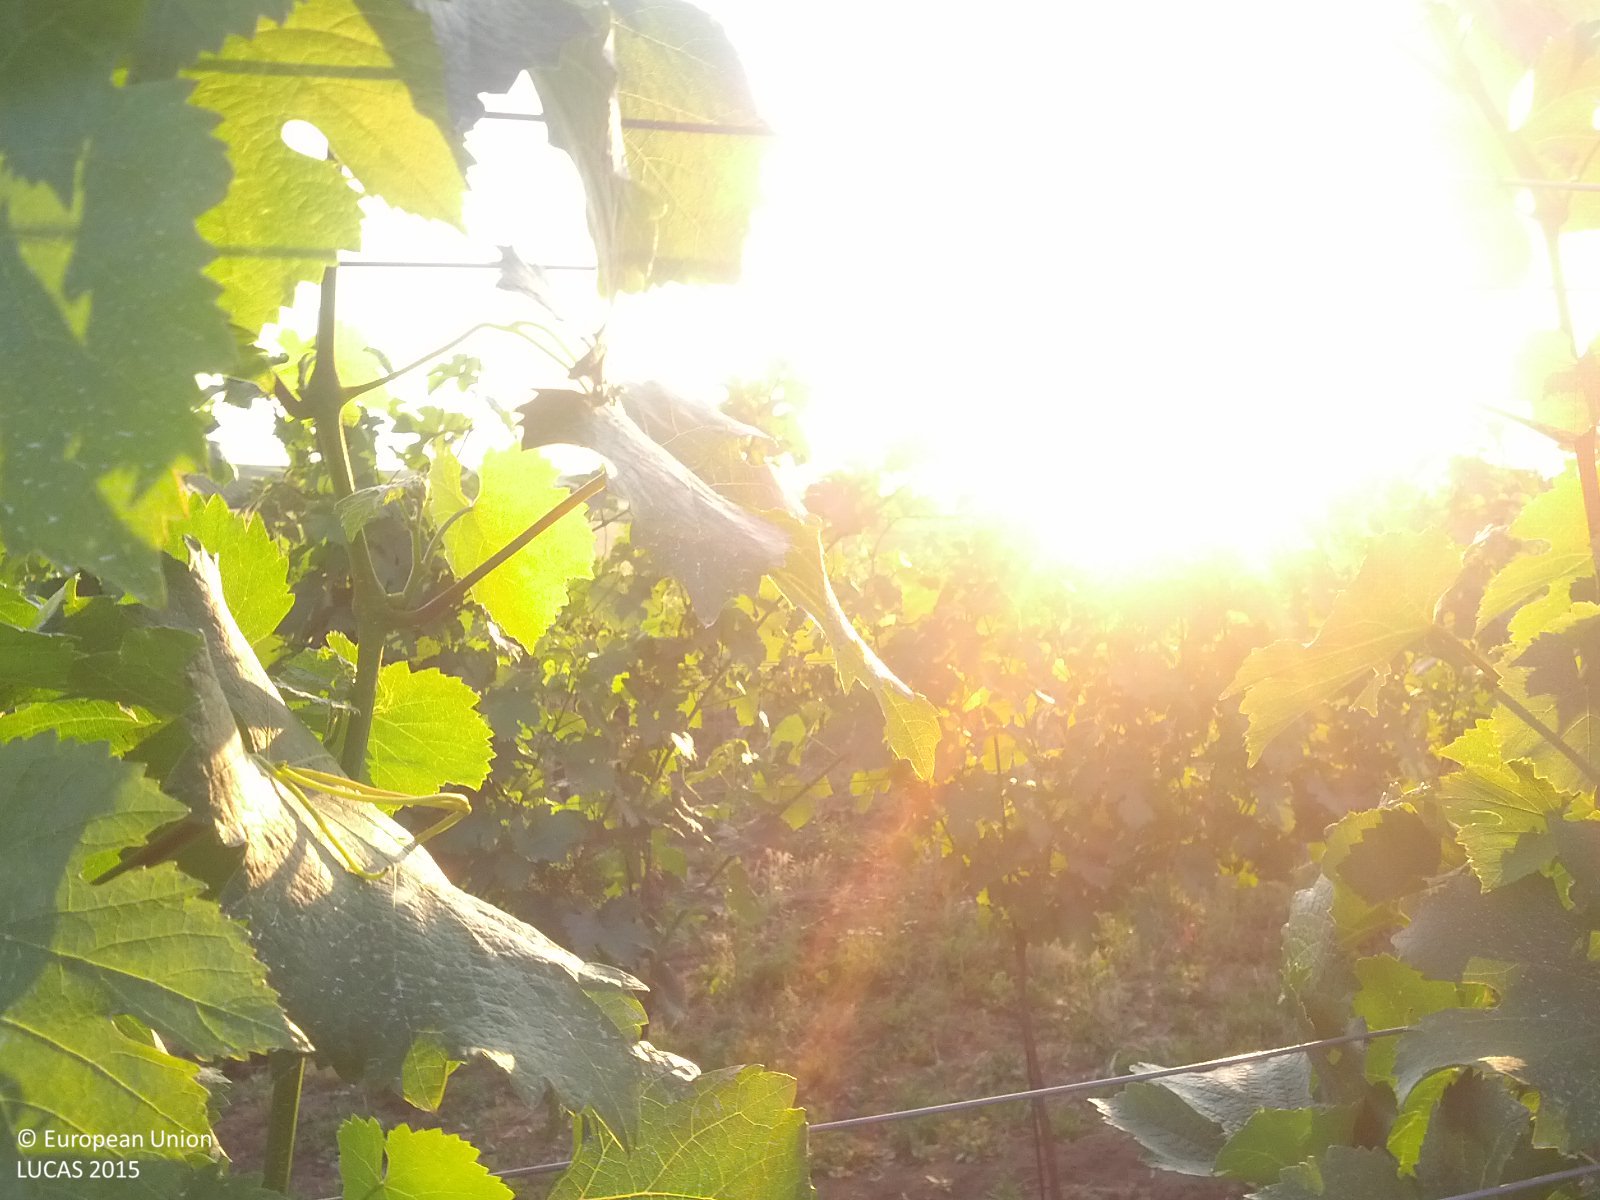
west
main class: Cropland
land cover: Vineyards
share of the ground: 25 - 50 %
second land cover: Spontaneously vegetated surfaces
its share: < 10 %
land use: Agriculture (excluding fallow land and kitchen gardens)
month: July
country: AT
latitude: 48.6369
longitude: 16.6427
